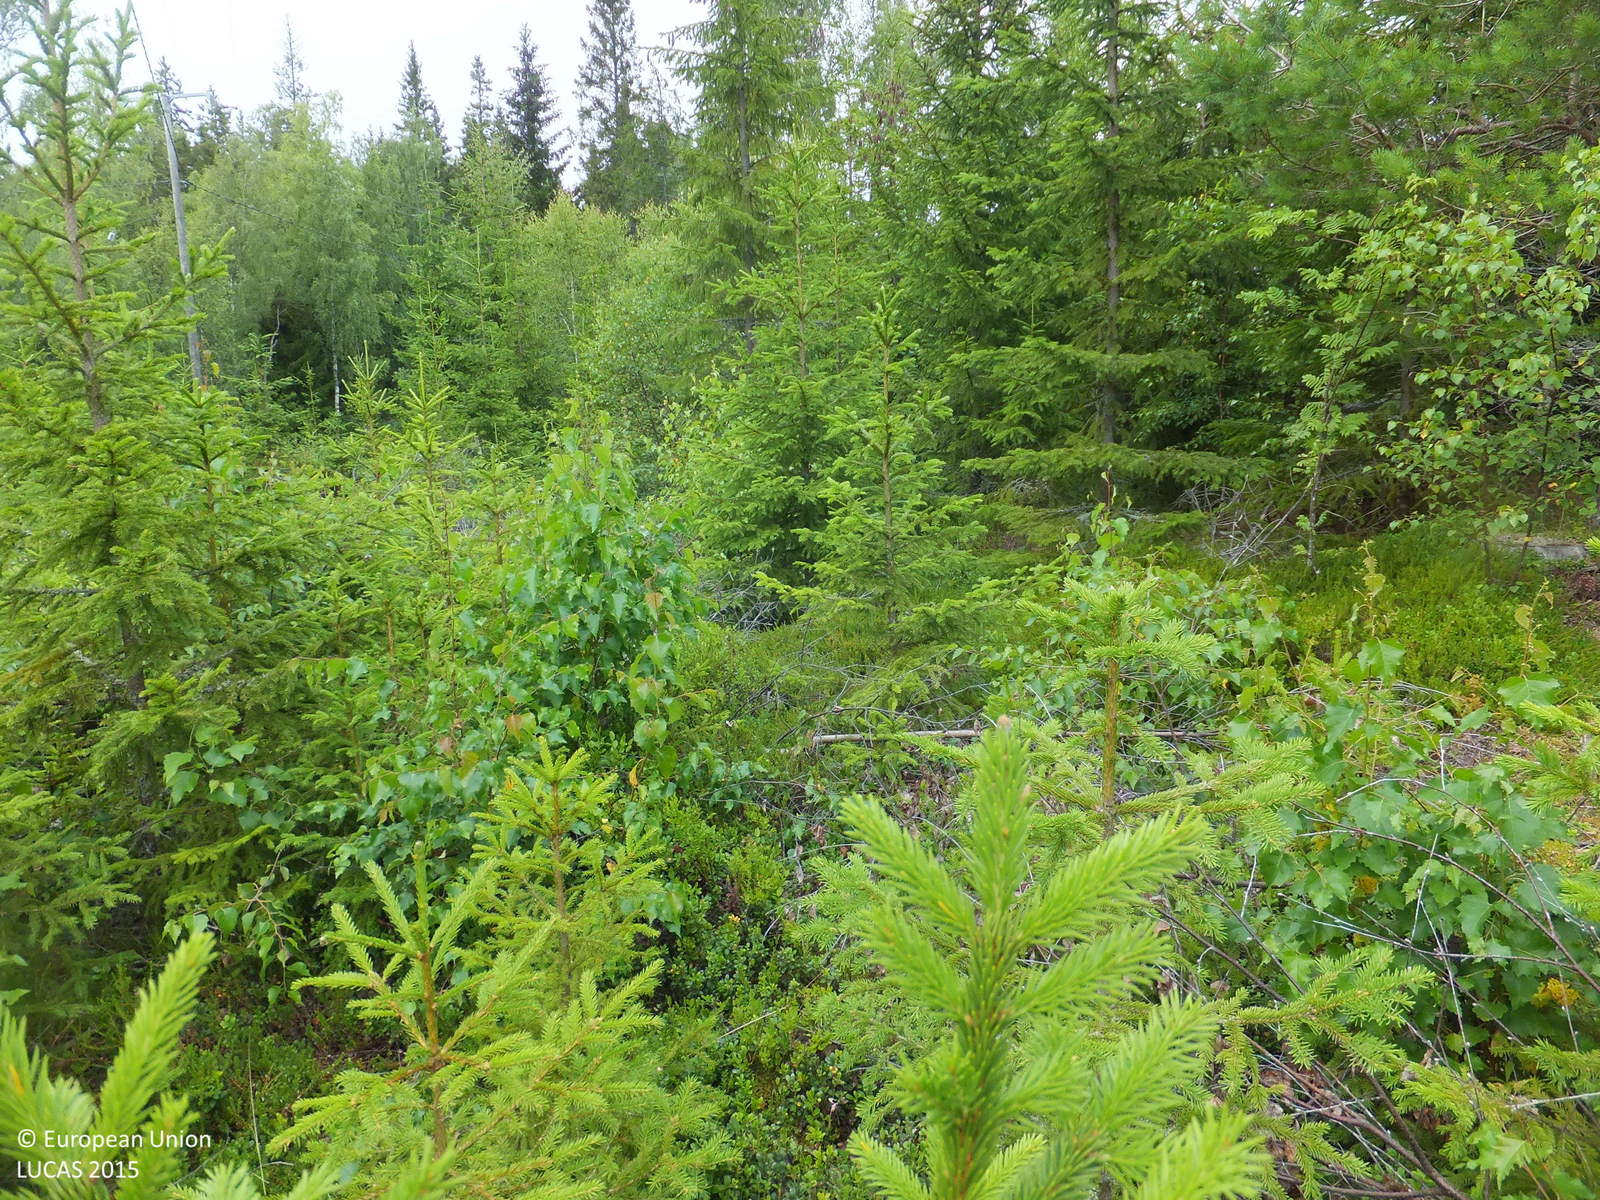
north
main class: Woodland
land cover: Spruce dominated mixed woodland
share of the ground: 25 - 50 %
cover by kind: shrubs 40 %, coniferous forest trees 15 %, broadleaved forest trees 15 %, herbaceous plants 10 %, lichens and mosses 10 %, consolidated bare surface 10 %
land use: Forestry
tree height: < 5 m
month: July
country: FI
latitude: 63.2954
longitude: 21.1029
